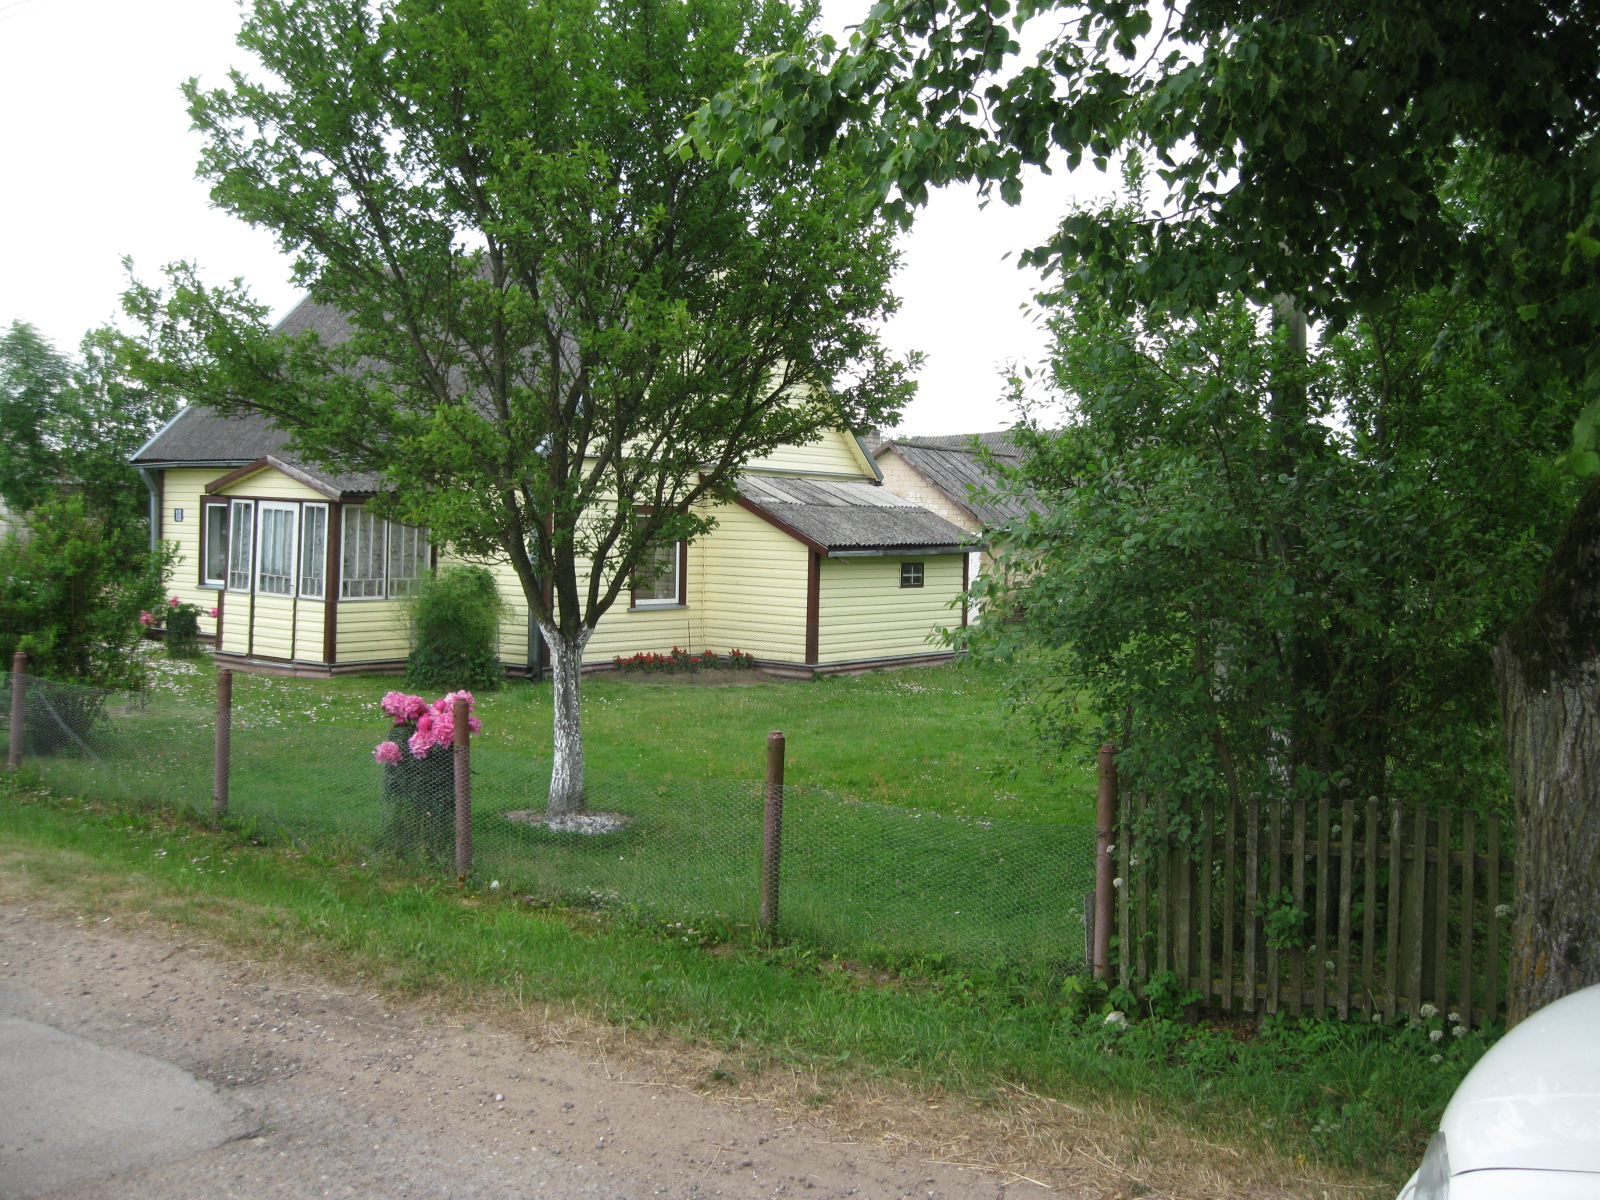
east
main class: Grassland
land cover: Grassland with sparse tree/shrub cover
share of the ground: > 75 %
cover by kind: herbaceous plants 90 %, broadleaved forest trees 5 %, shrubs 5 %
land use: Agriculture (excluding fallow land and kitchen gardens)
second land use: Residential
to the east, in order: Grassland with sparse tree/shrub cover; Artificial constructions in urban areas; Arable land (only in case pi)
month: June
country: LT
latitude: 55.3265
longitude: 24.1361
